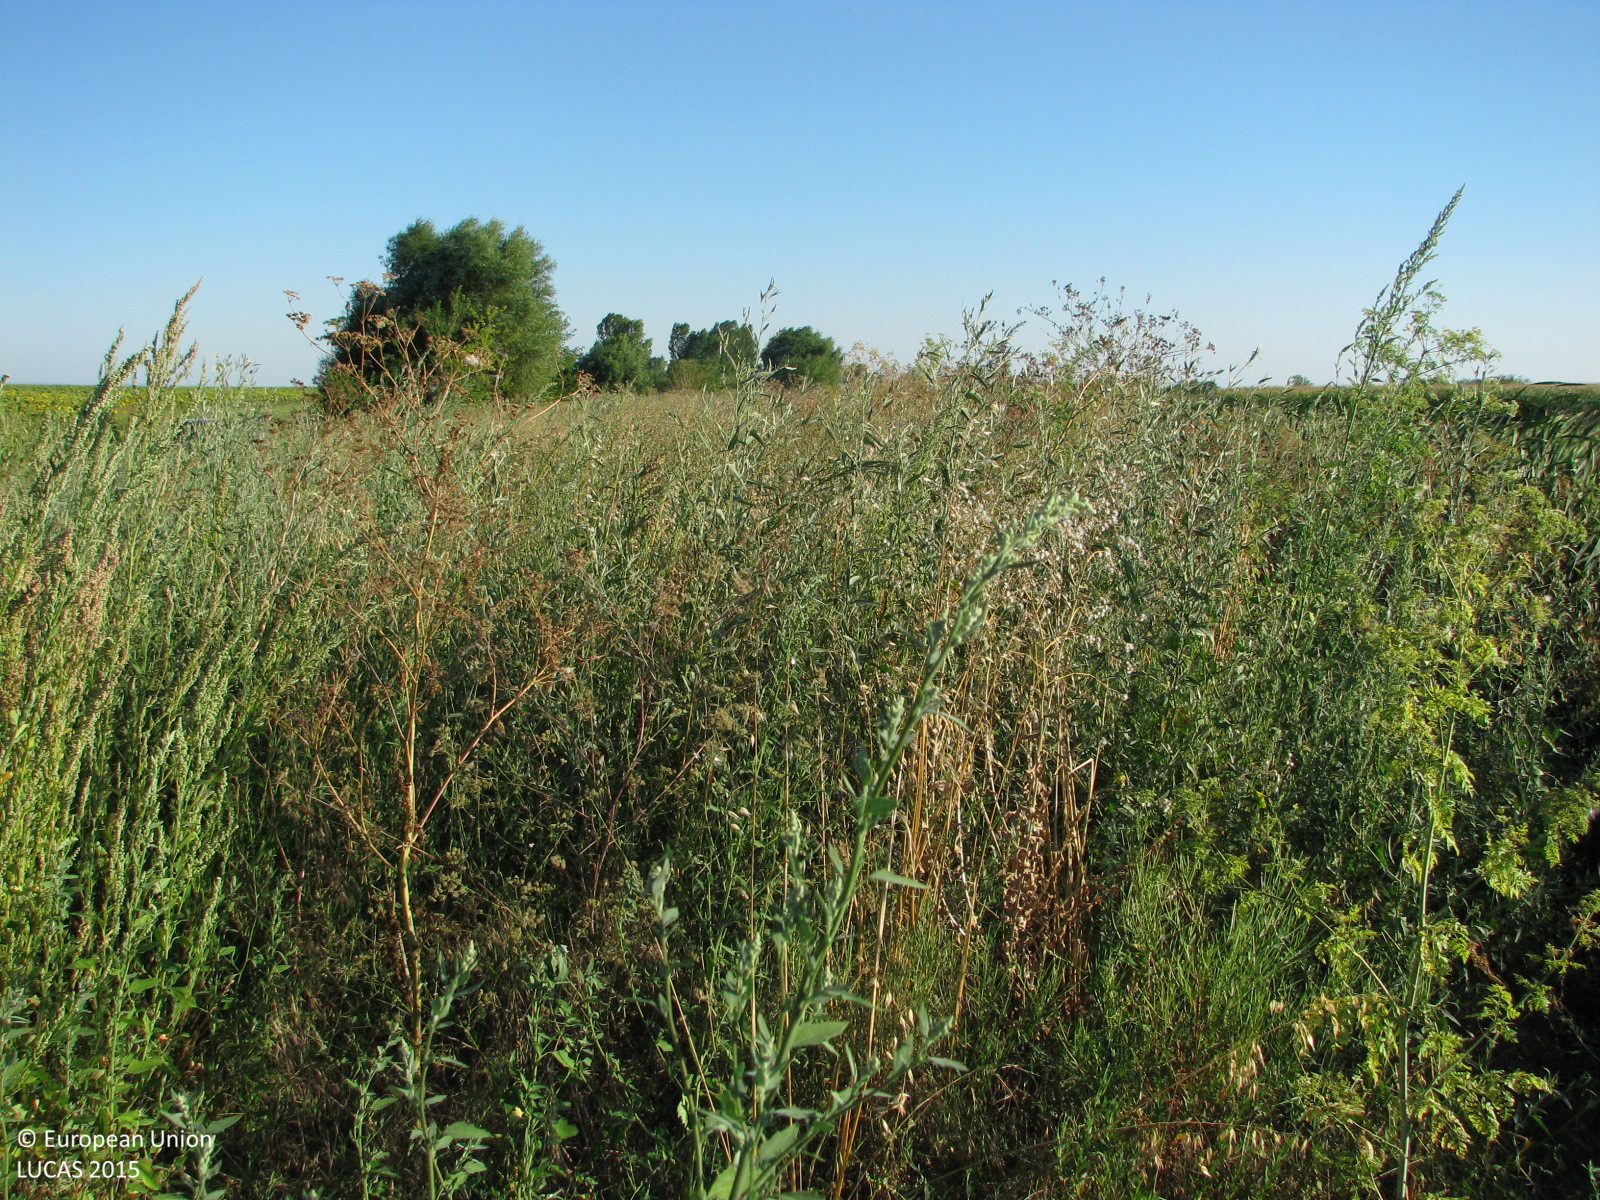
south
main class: Cropland
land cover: Maize
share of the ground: > 75 %
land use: Agriculture (excluding fallow land and kitchen gardens)
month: July
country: BG
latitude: 42.4254
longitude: 25.9645
